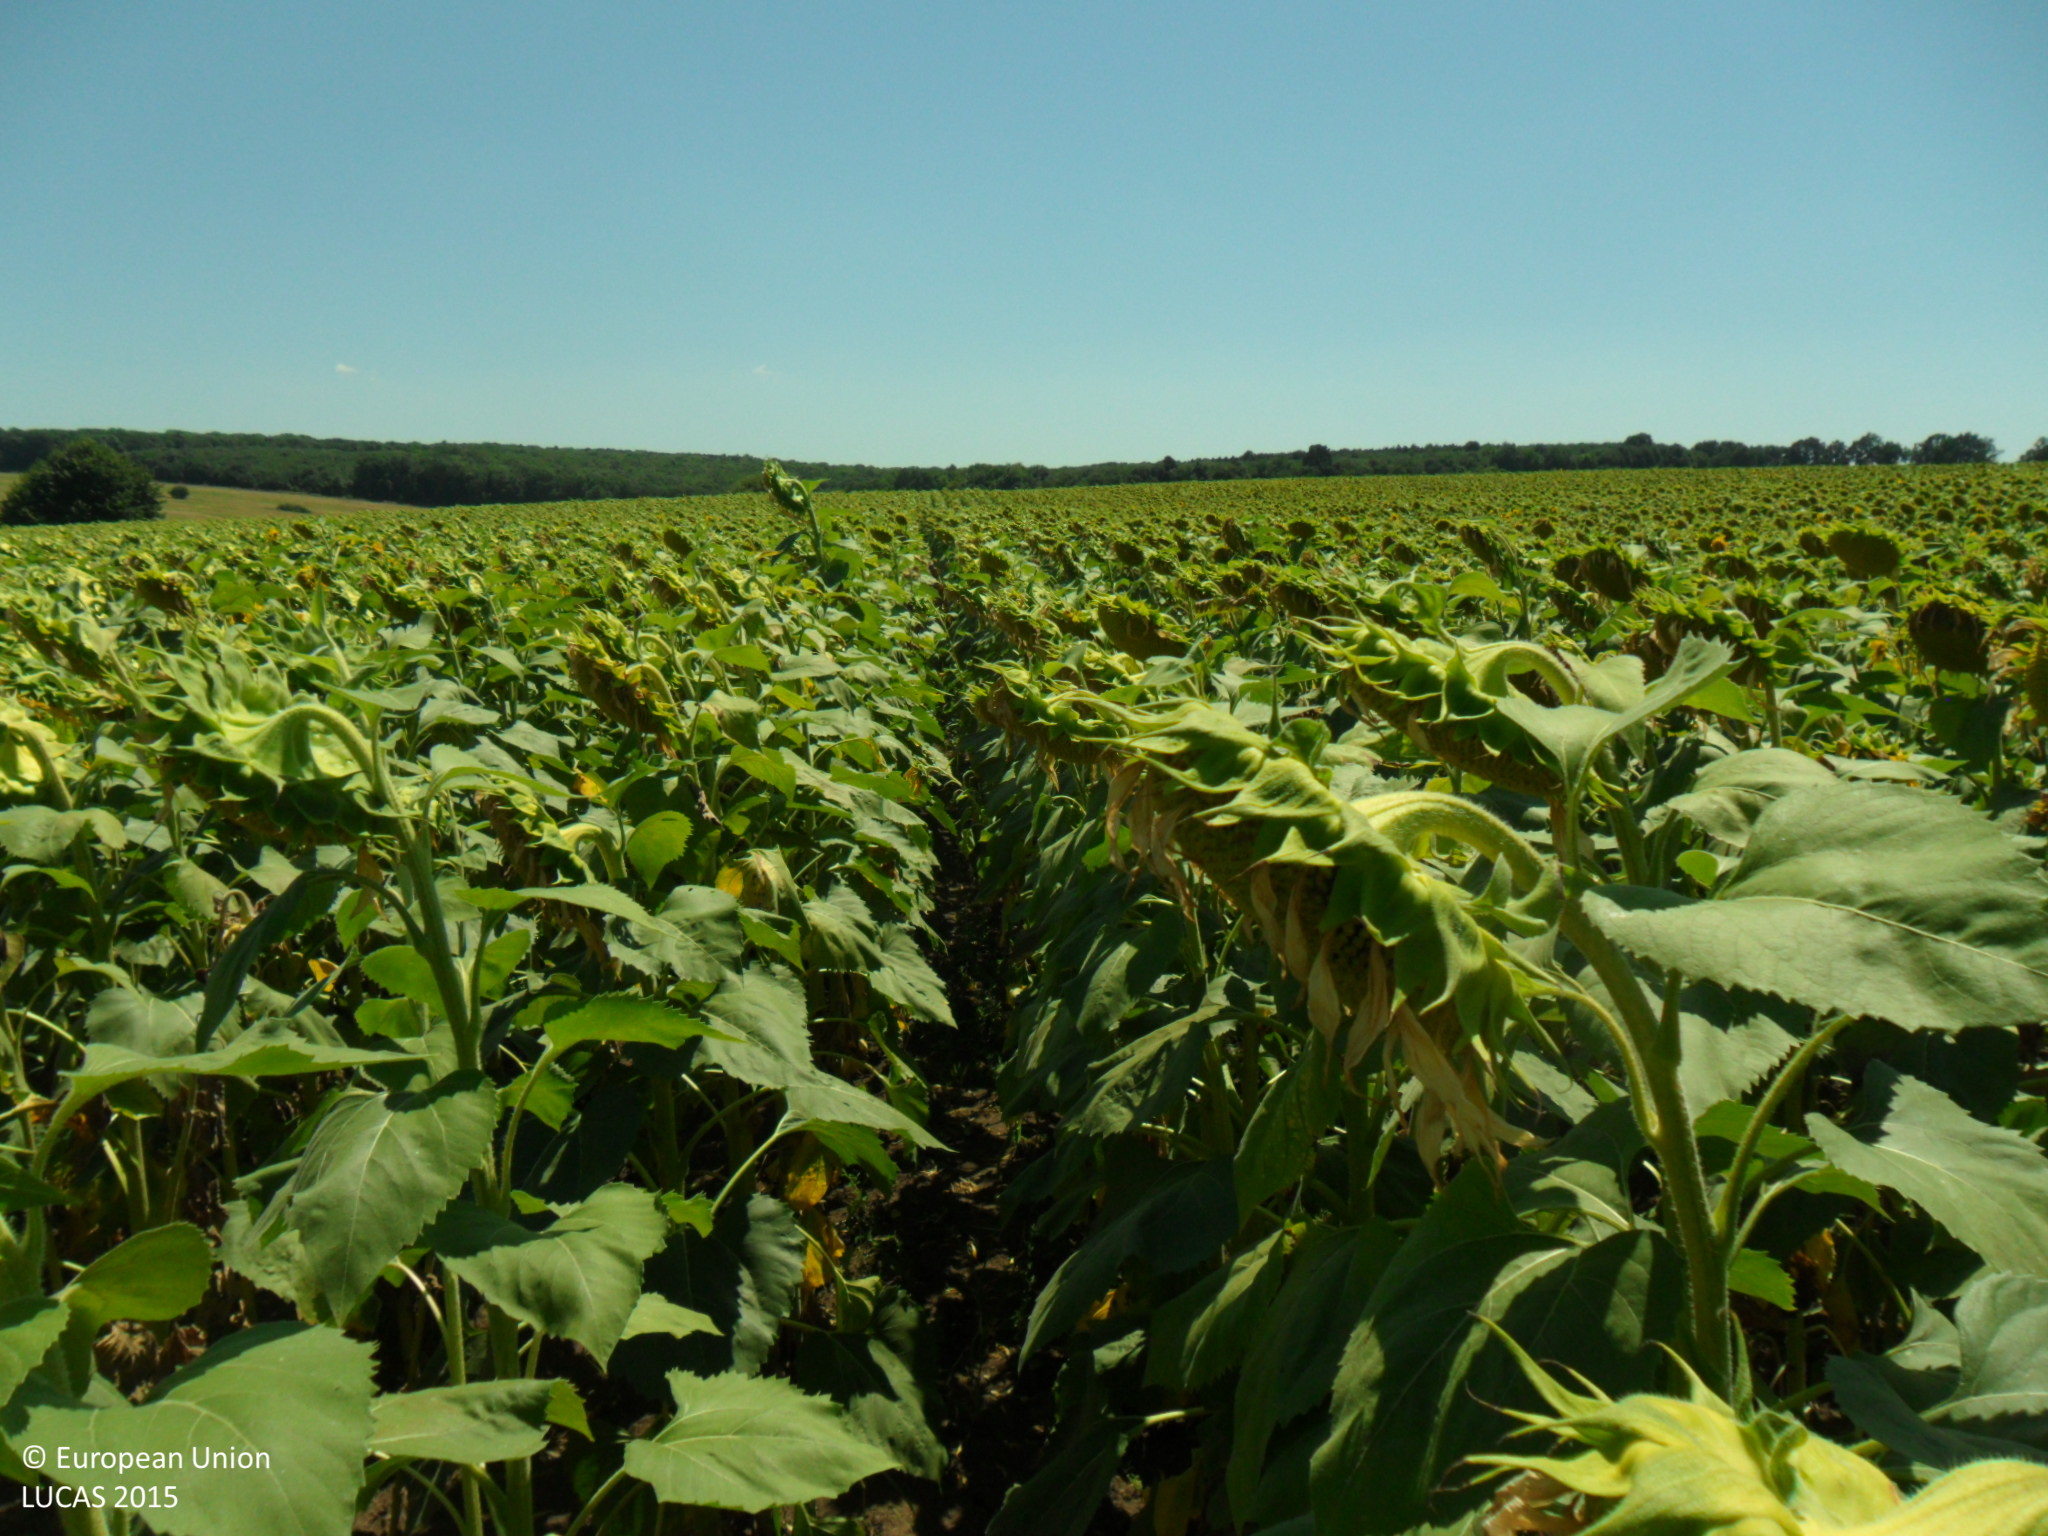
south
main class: Cropland
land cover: Sunflower
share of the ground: > 75 %
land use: Agriculture (excluding fallow land and kitchen gardens)
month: July
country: BG
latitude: 43.8415
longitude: 26.4123
